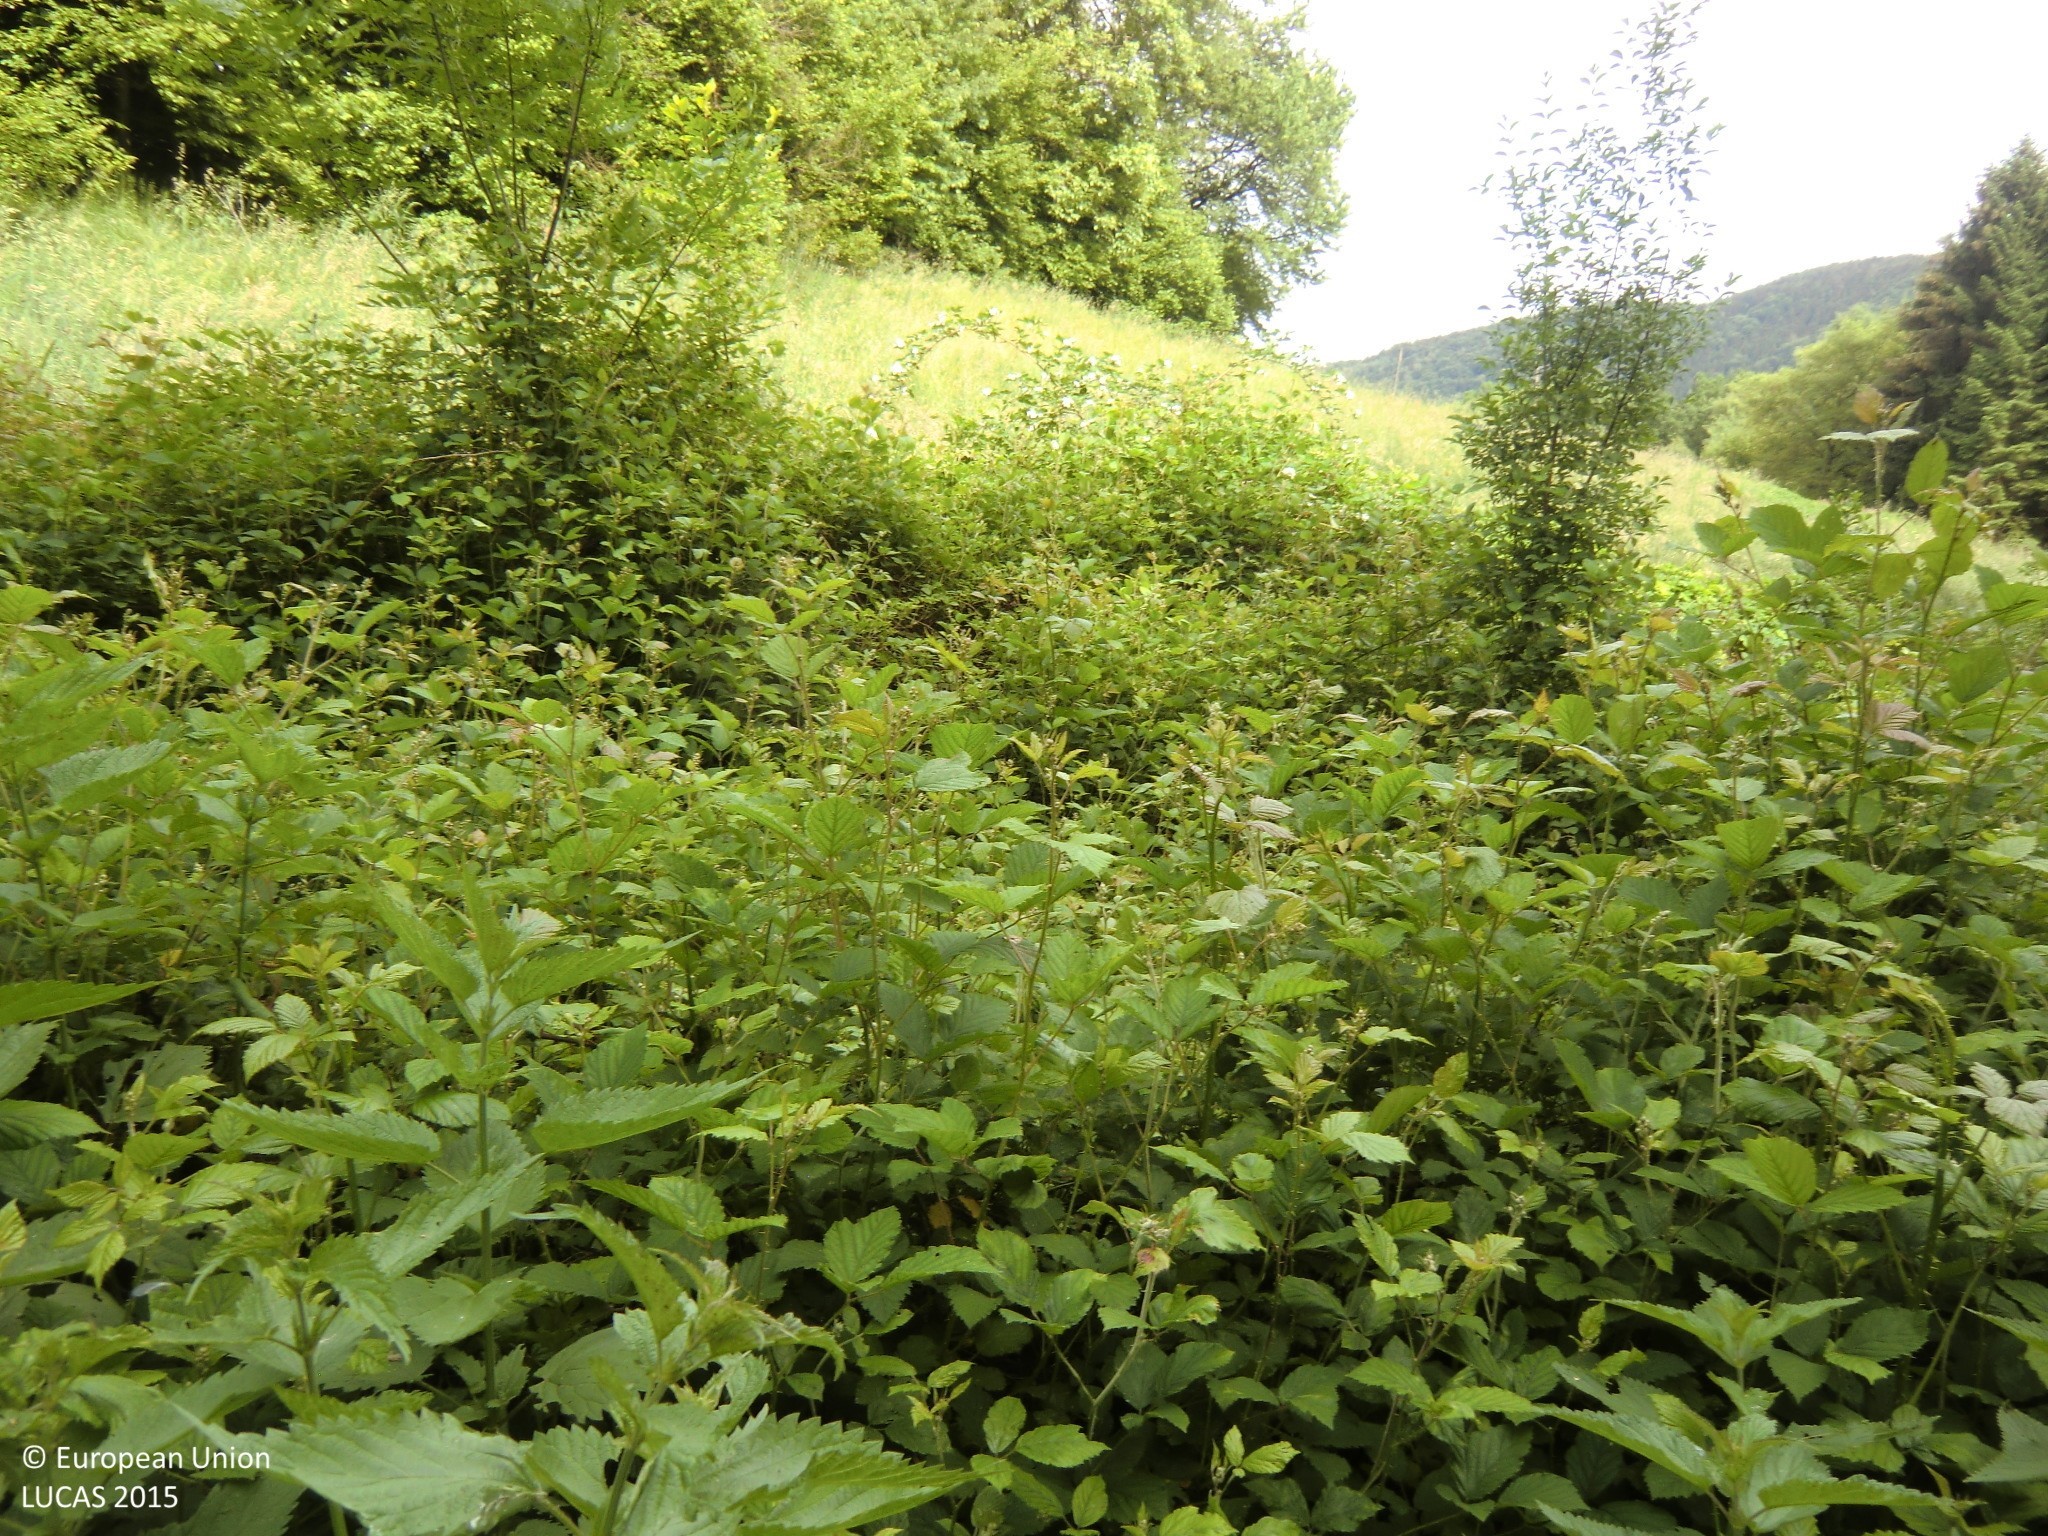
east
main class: Grassland
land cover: Spontaneously vegetated surfaces
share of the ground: > 75 %
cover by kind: herbaceous plants 100 %
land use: Agriculture (excluding fallow land and kitchen gardens)
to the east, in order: Spontaneously vegetated surfaces; Fences; Spontaneously vegetated surfaces; Grassland without tree/shrub cover; Broadleaved woodland; Fences; Grassland without tree/shrub cover; Electric lines; Grassland without tree/shrub cover; Fences; Broadleaved woodland; Tracks; Grassland without tree/shrub cover
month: May
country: AT
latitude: 48.1994
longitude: 15.0197
